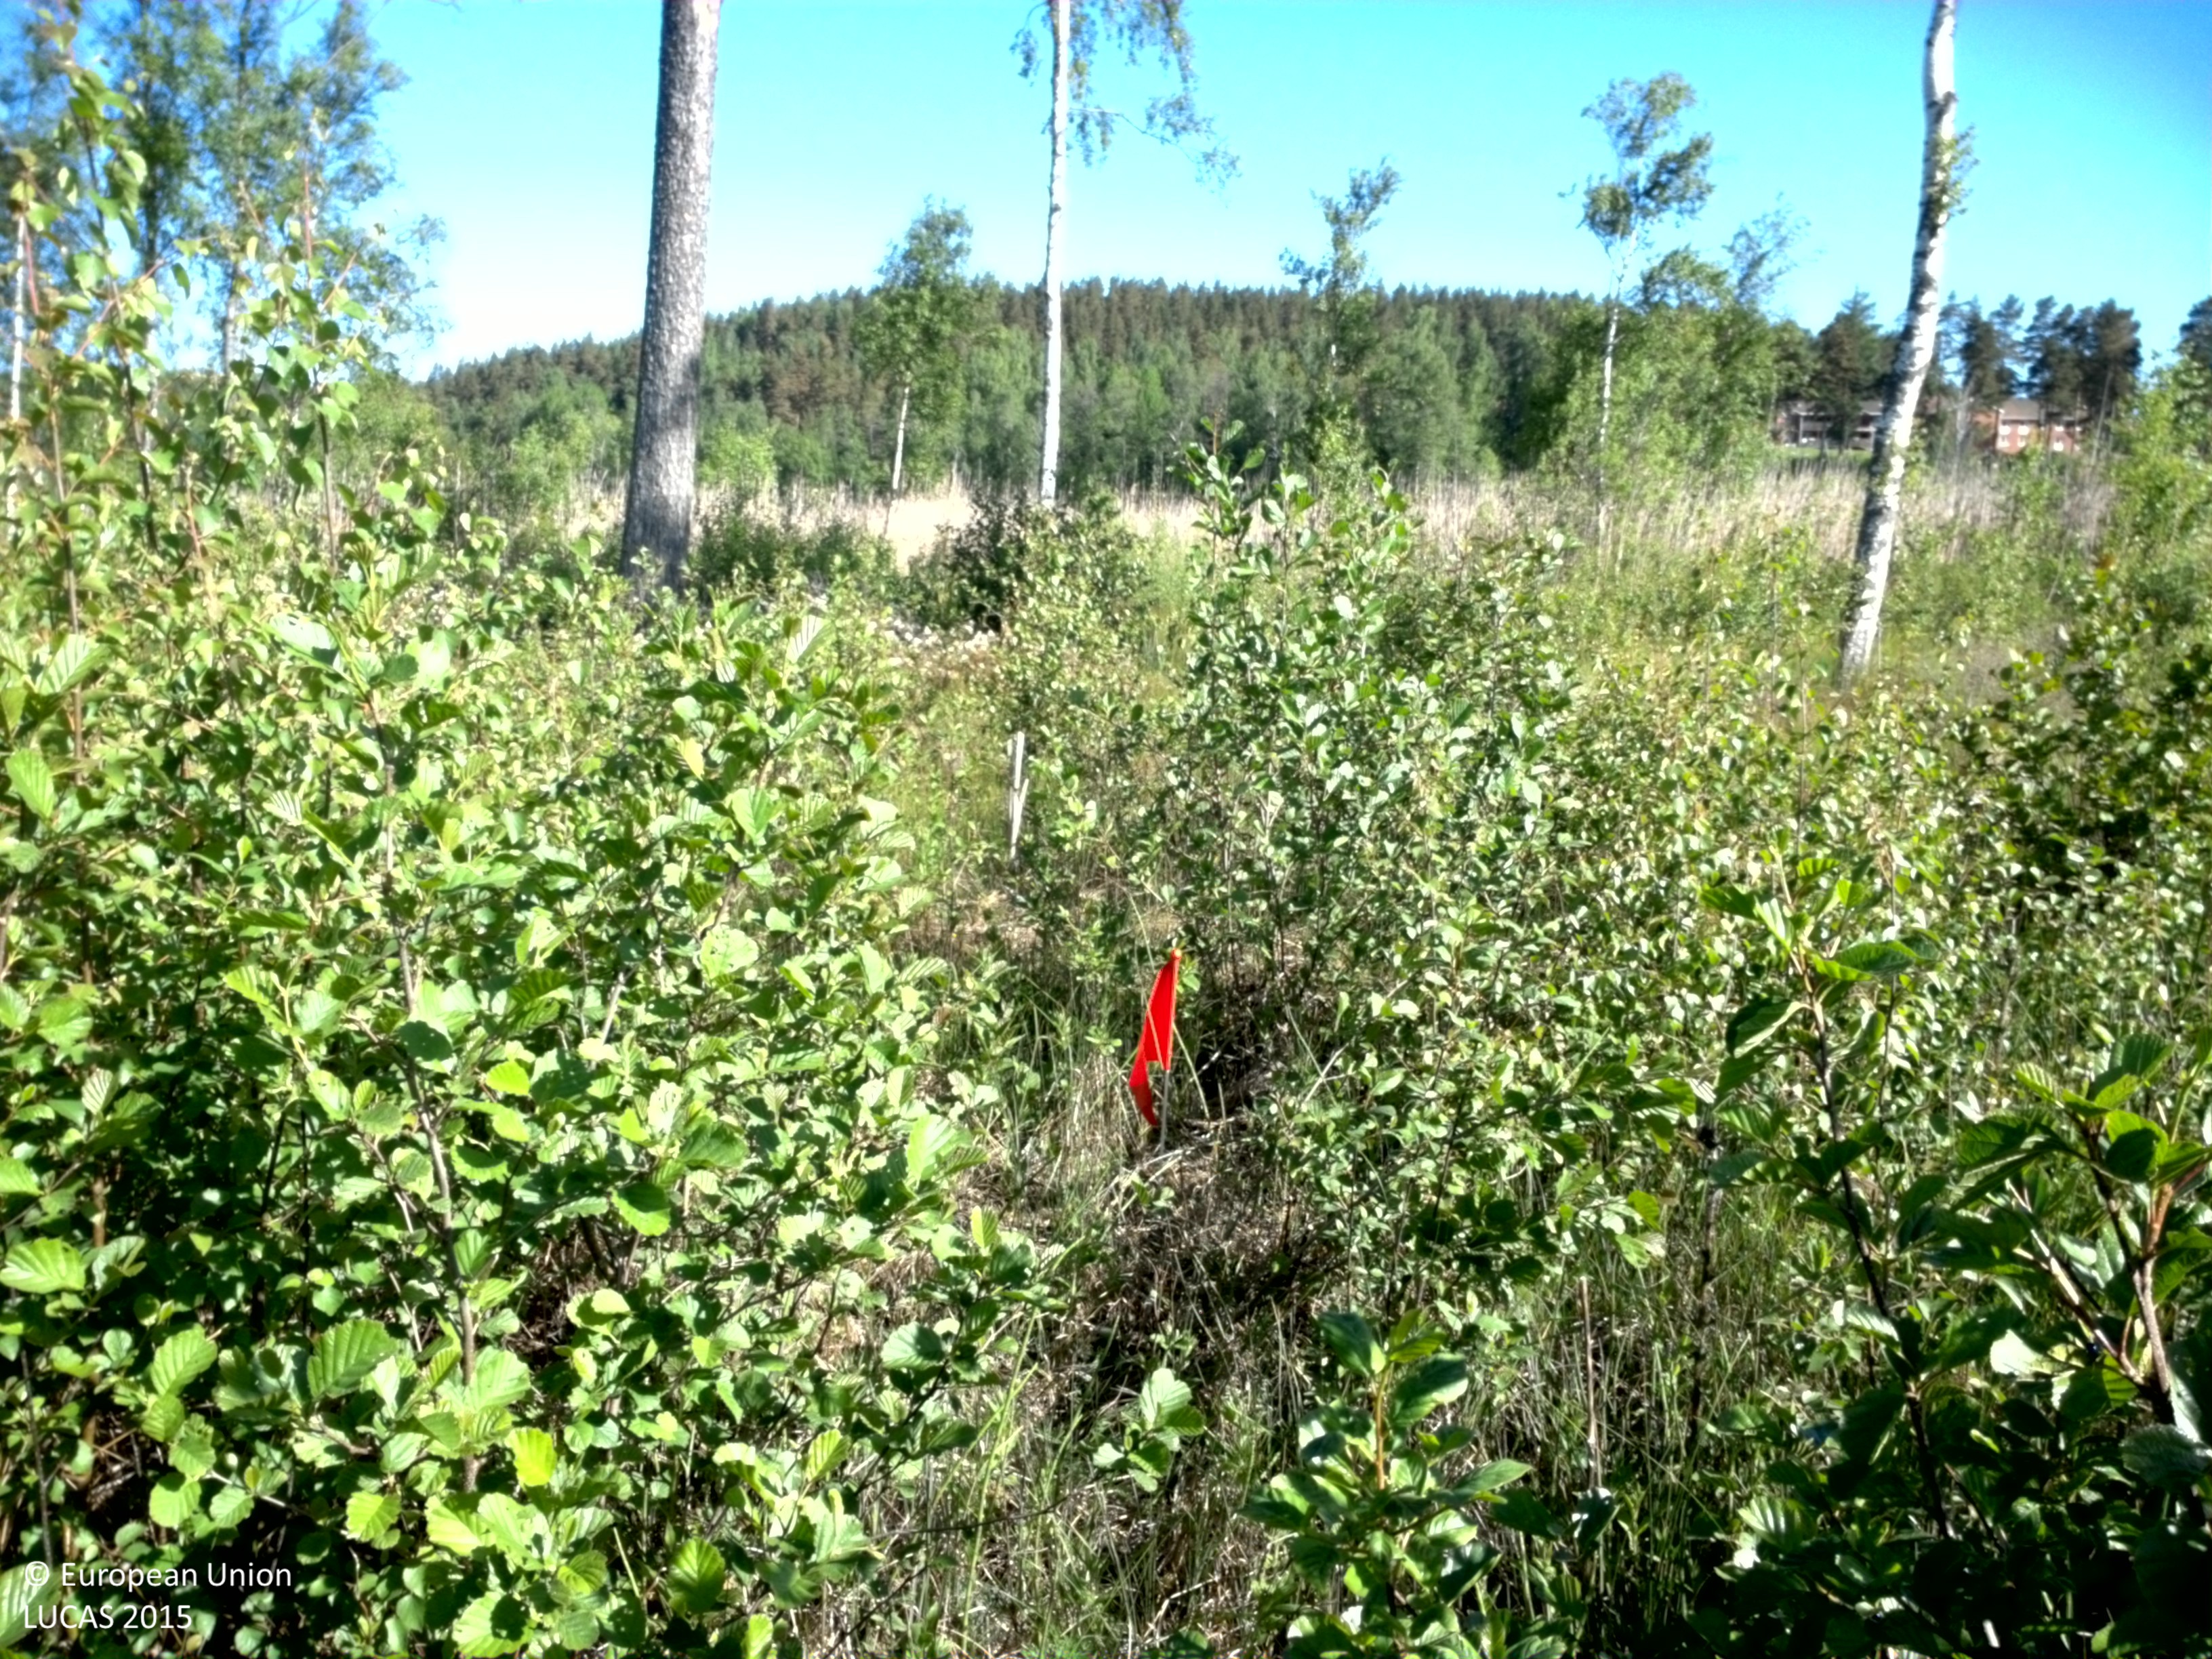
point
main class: Woodland
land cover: Broadleaved woodland
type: mire and swamp forests
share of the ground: > 75 %
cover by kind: broadleaved forest trees 90 %, coniferous forest trees 5 %, shrubs 5 %
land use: Forestry
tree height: < 5 m
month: June
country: SE
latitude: 58.4898
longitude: 14.4021
